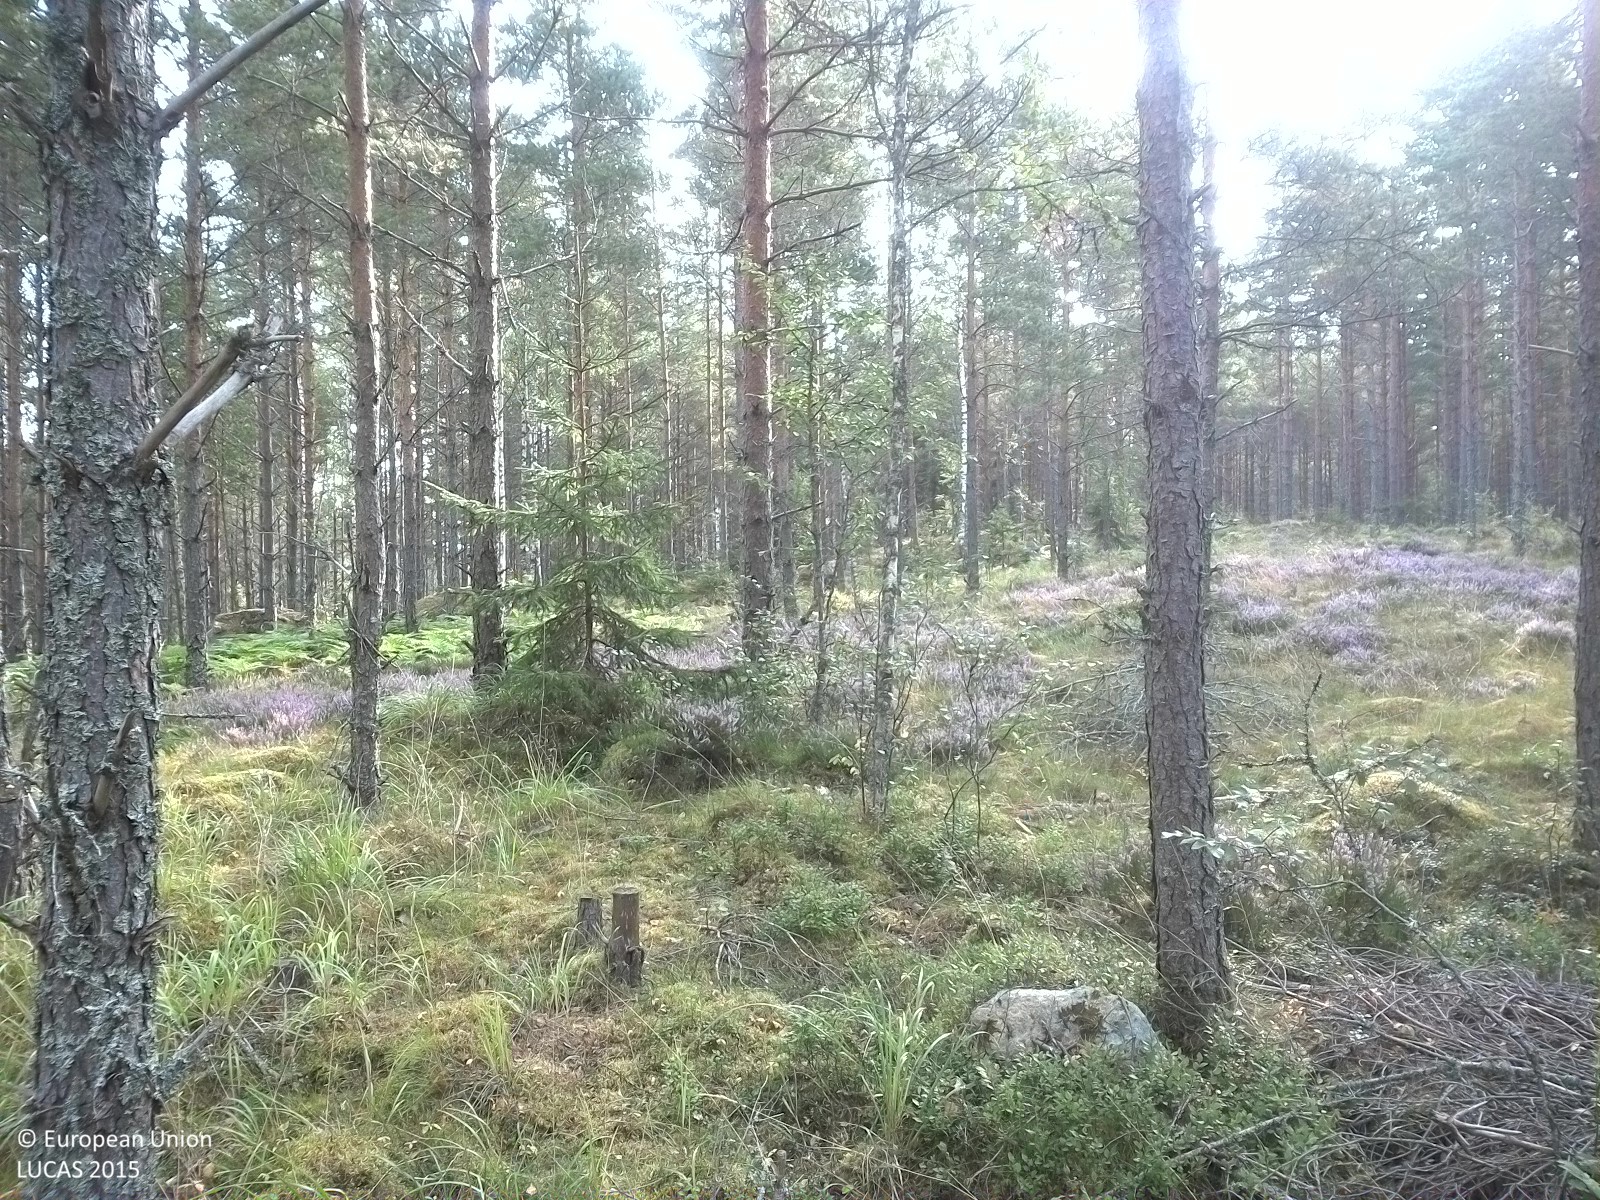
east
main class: Woodland
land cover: Pine dominated coniferous woodland
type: boreal forest
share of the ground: 25 - 50 %
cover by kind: herbaceous plants 35 %, coniferous forest trees 30 %, lichens and mosses 20 %, shrubs 10 %, broadleaved forest trees 5 %
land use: Forestry
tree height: > 5 m
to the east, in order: Pine dominated coniferous woodland; Tracks; Pine dominated coniferous woodland; Tracks; Pine dominated coniferous woodland; Pine dominated mixed woodland; Ditches and canals; Paved roads, cycling and walking lanes; Shruby margins; Other mixed woodland; Tracks; Other coniferous woodland; Tracks; Other coniferous woodland
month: August
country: SE
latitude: 58.8291
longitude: 15.4841
